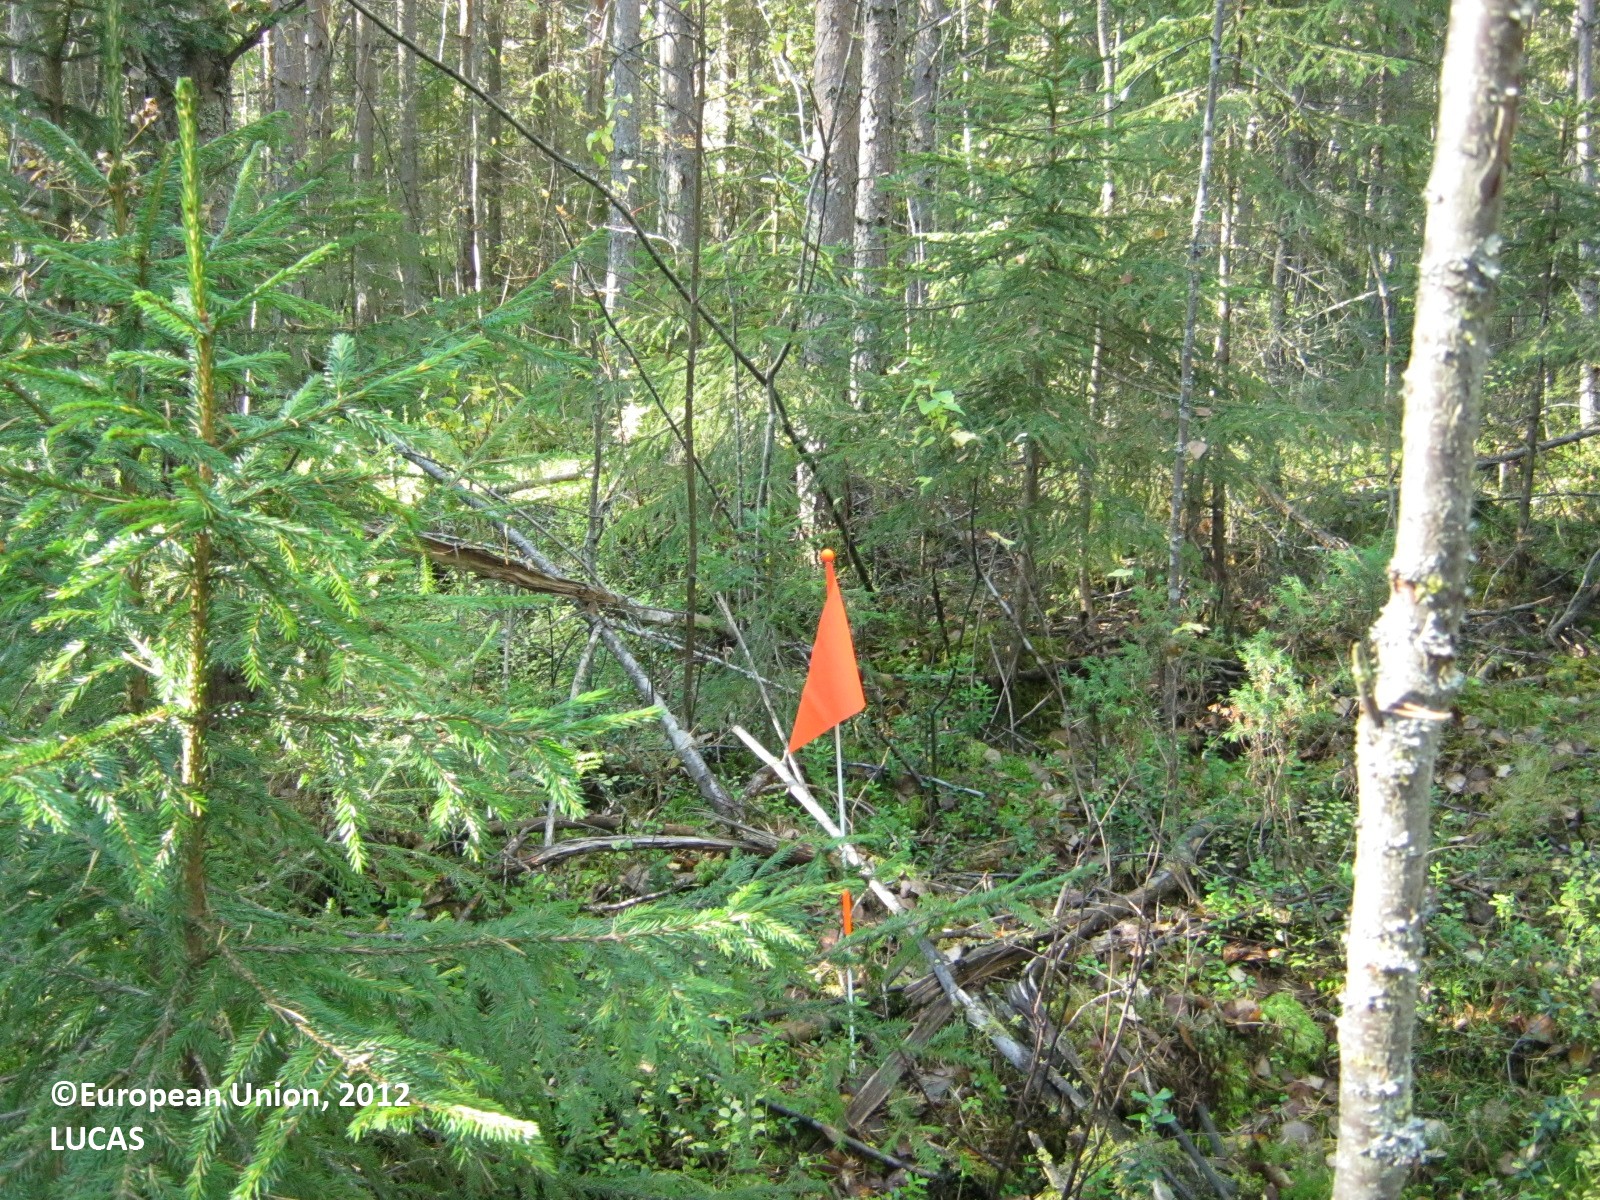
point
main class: Woodland
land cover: Spruce dominated coniferous woodland
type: boreal forest
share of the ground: > 75 %
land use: Forestry
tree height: > 5 m
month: September
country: FI
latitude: 63.2764
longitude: 25.8794
